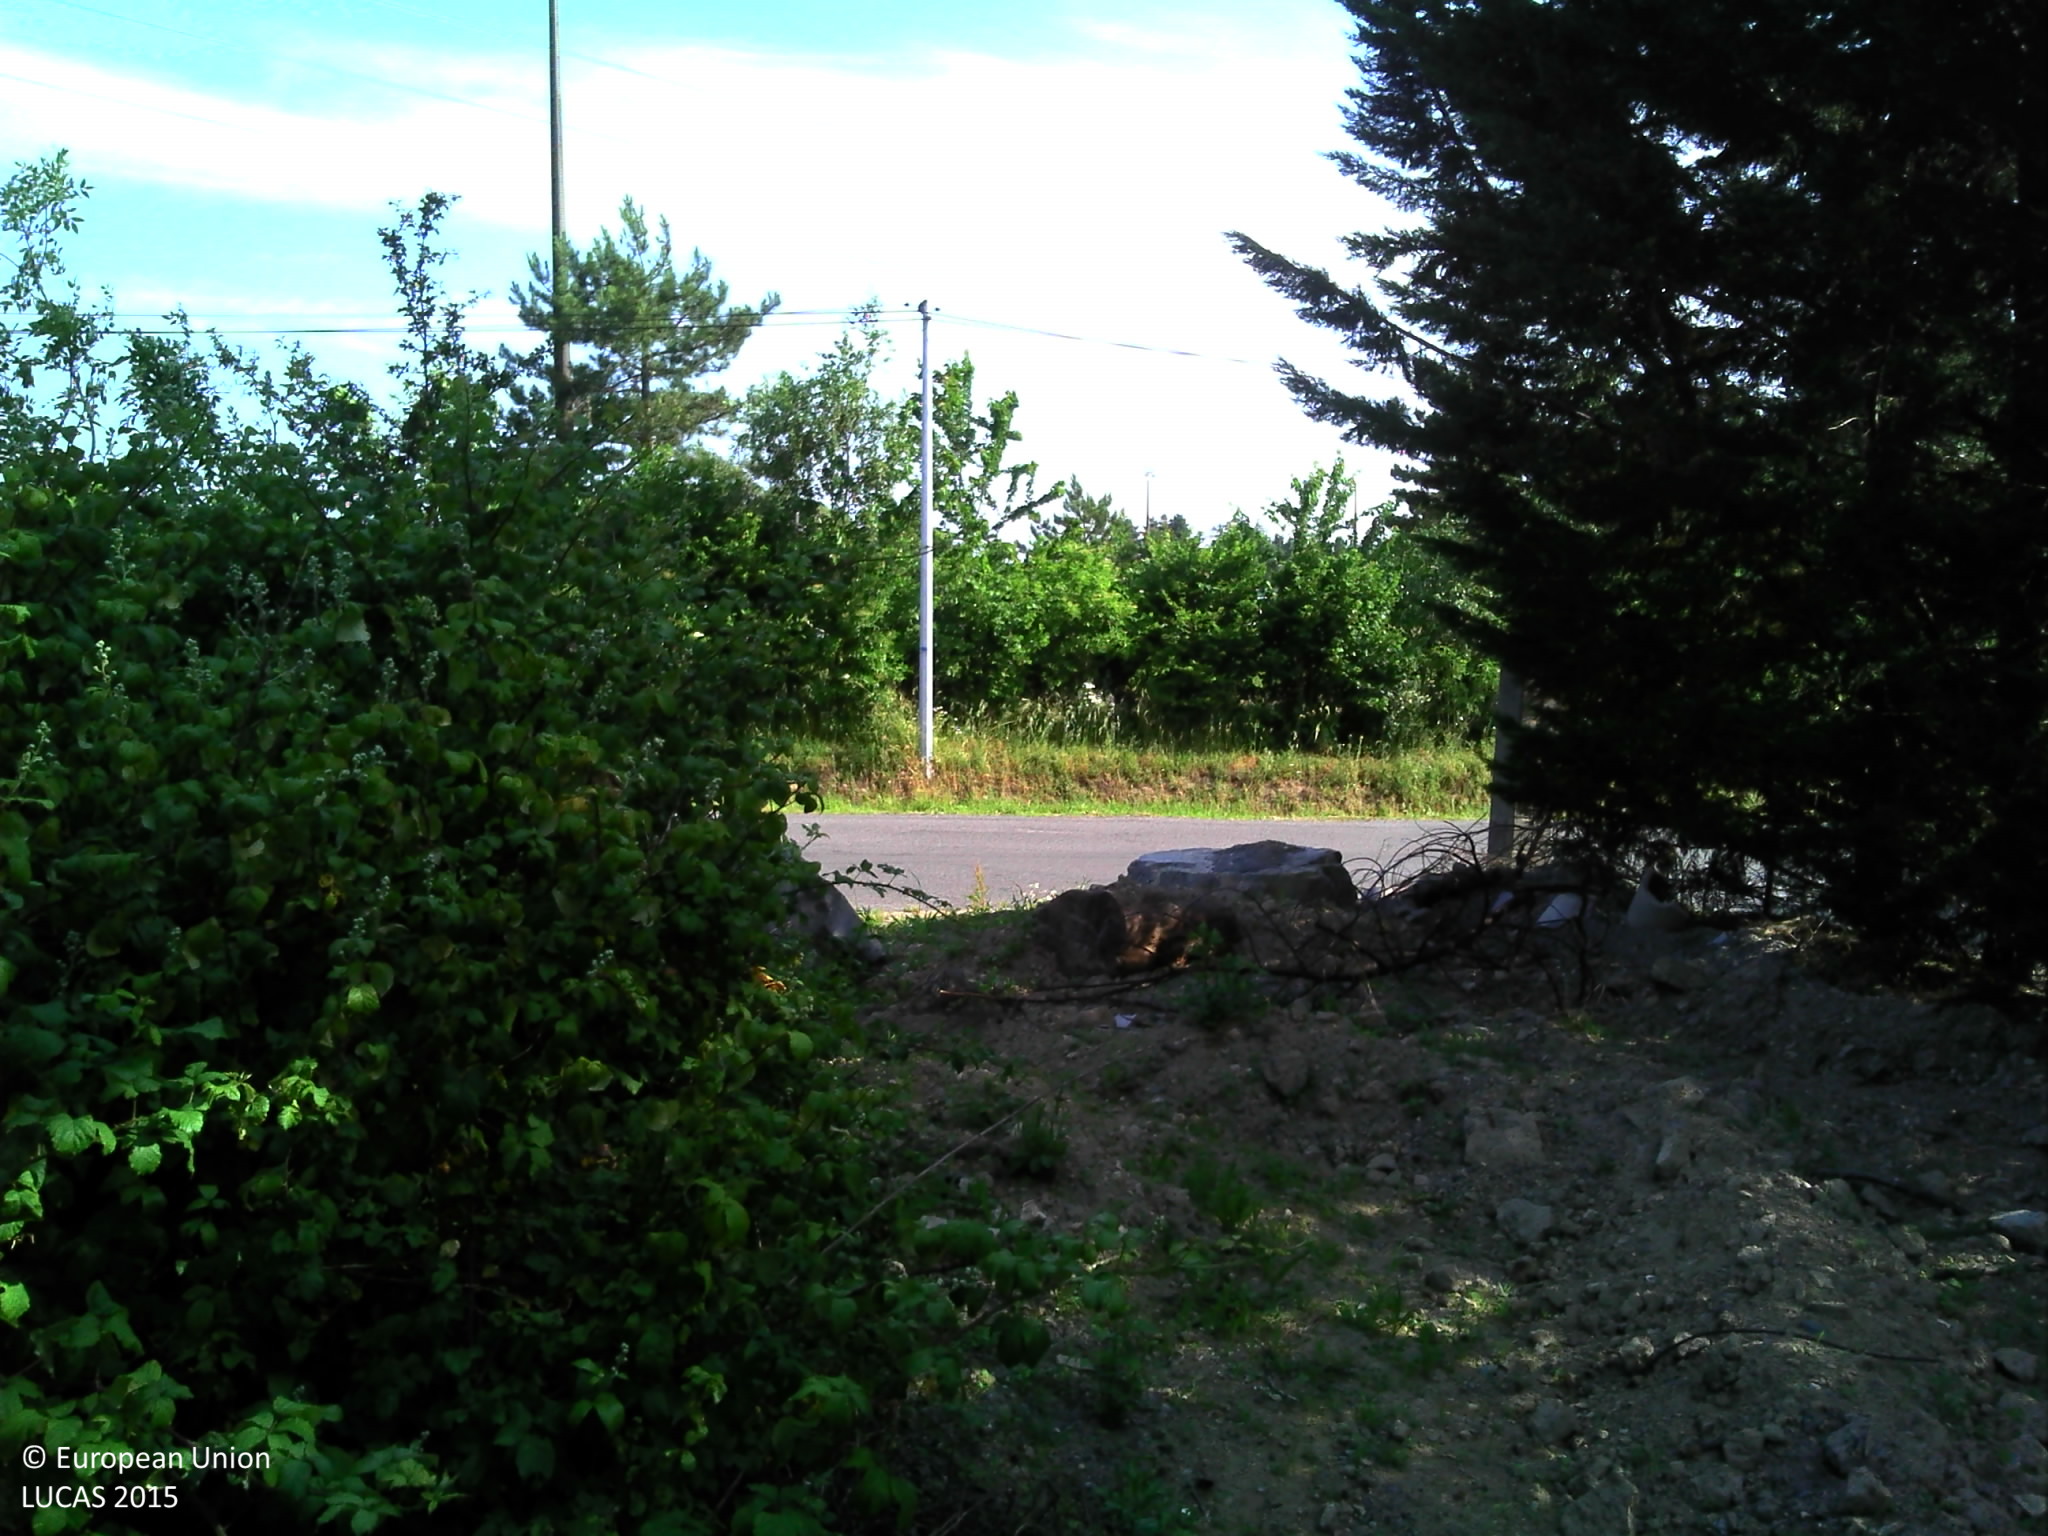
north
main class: Grassland
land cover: Spontaneously vegetated surfaces
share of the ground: > 75 %
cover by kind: herbaceous plants 95 %, shrubs 5 %
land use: Abandoned areas
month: June
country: FR
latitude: 47.1618
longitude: -1.5309
